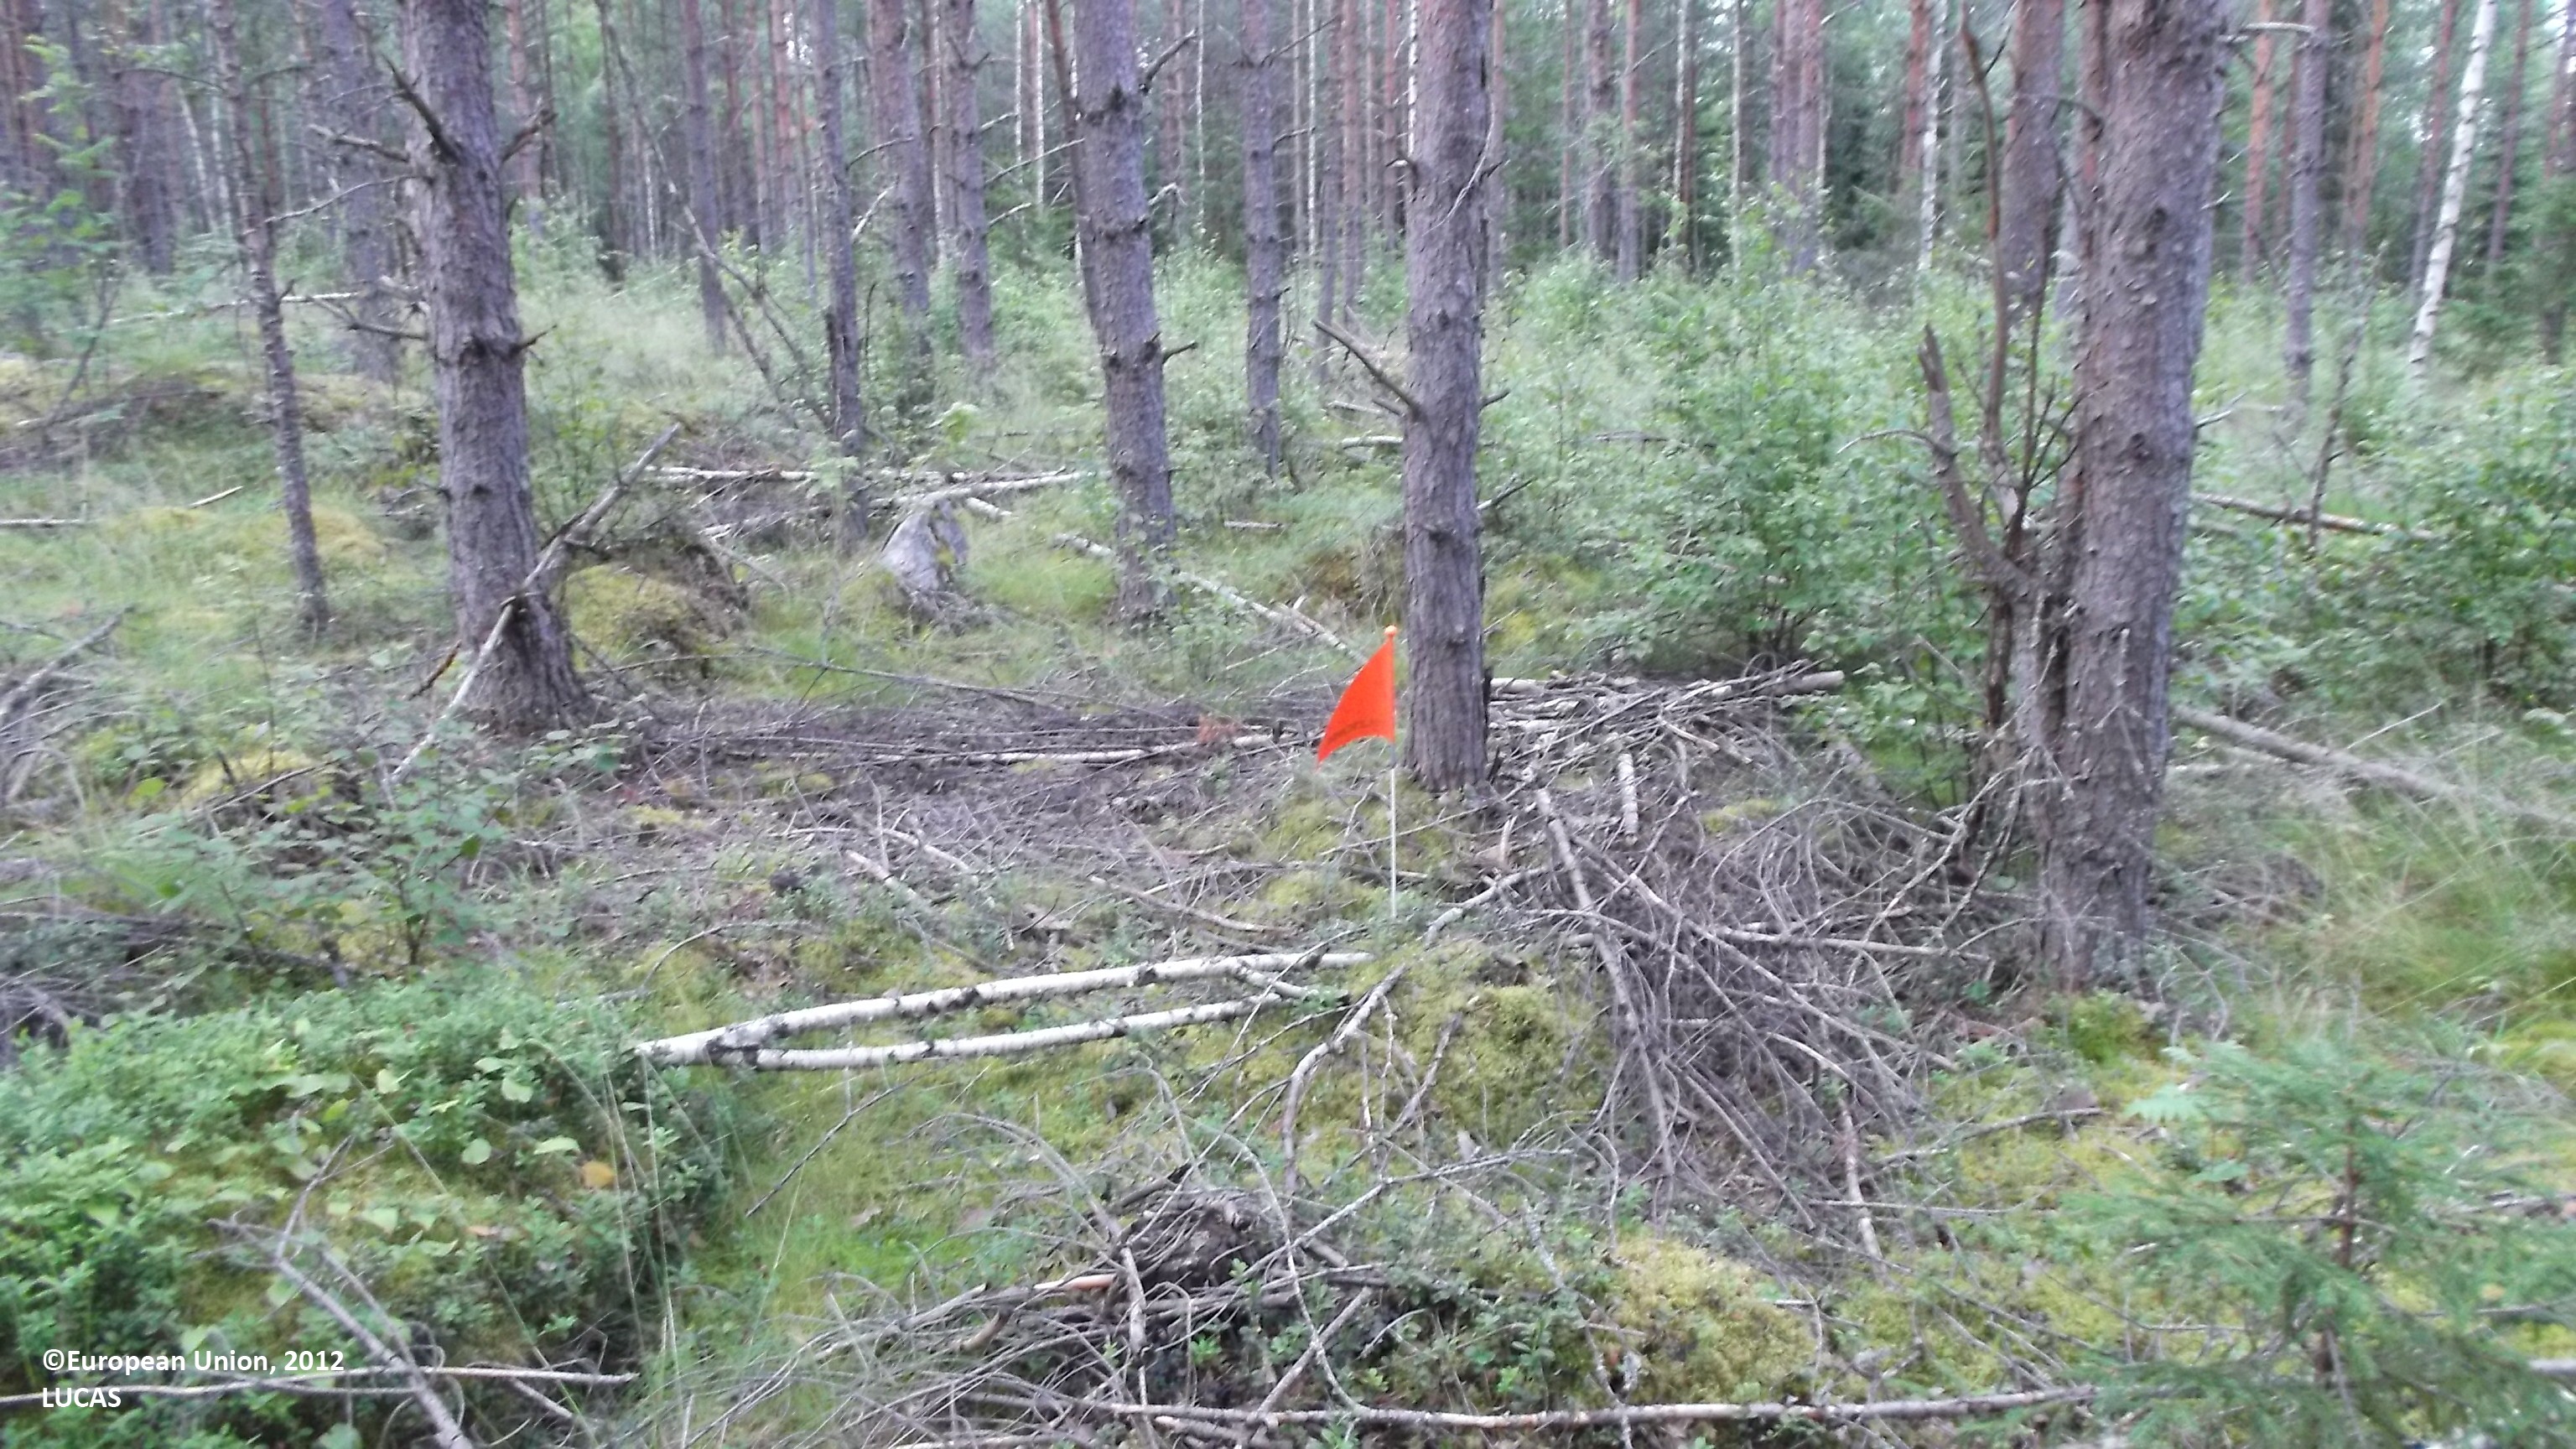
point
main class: Woodland
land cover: Pine dominated mixed woodland
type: boreal forest
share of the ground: 50 - 75 %
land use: Forestry
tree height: > 5 m
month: July
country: FI
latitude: 63.6143
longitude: 23.3084
